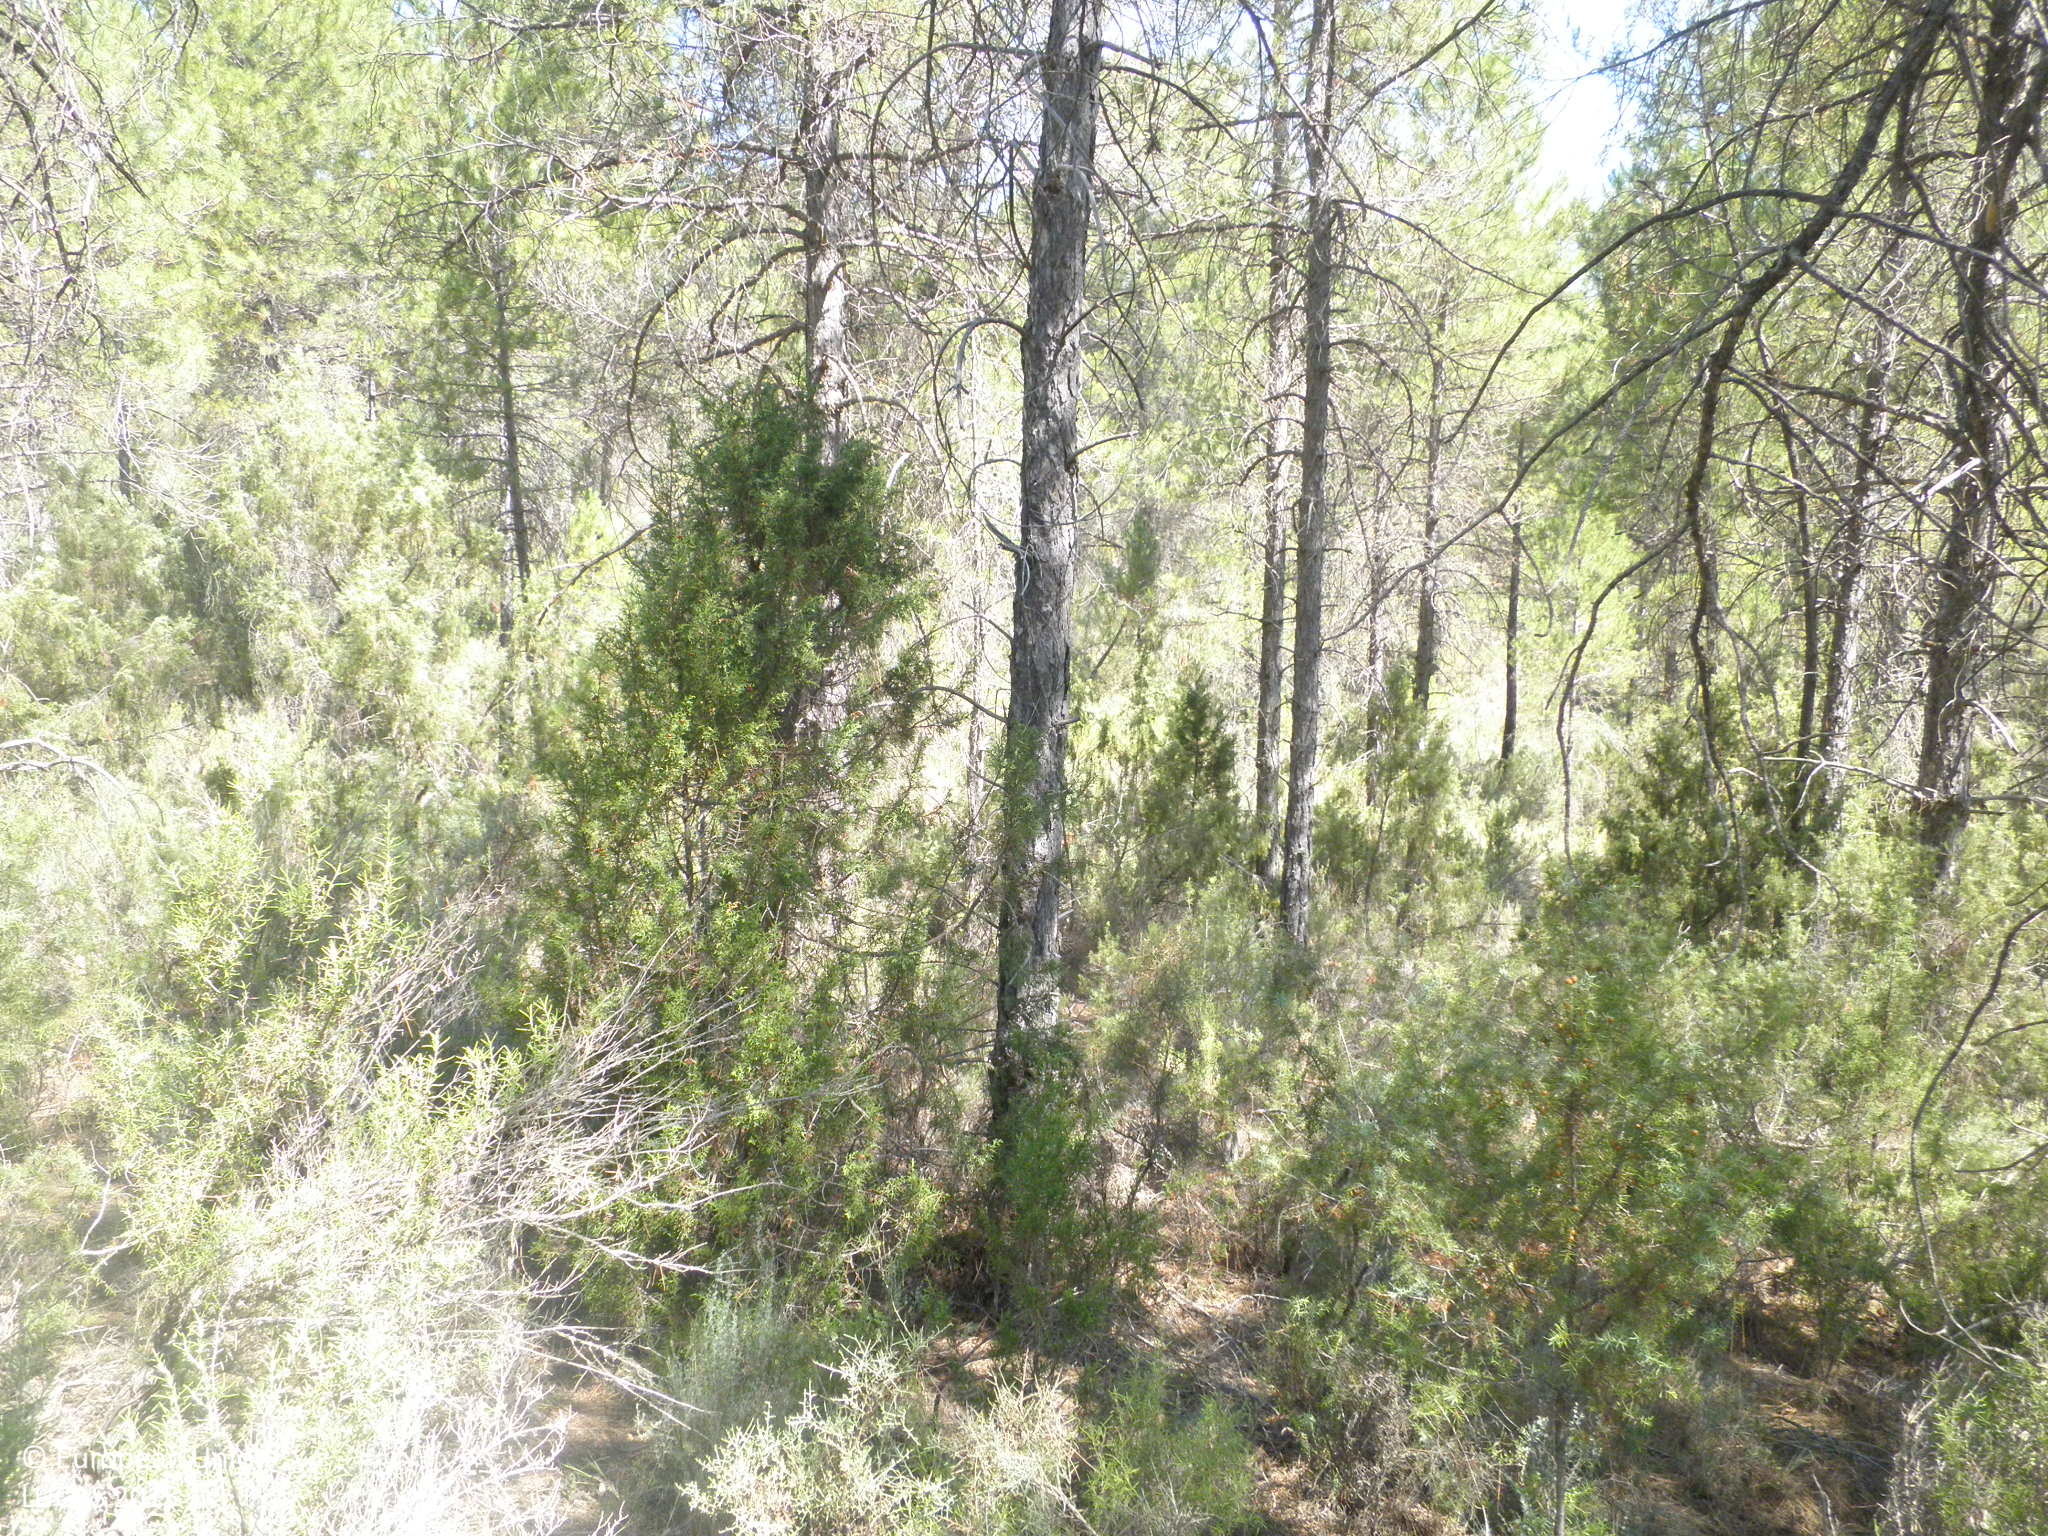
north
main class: Woodland
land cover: Pine dominated coniferous woodland
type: coniferous forest of the mediterranean region
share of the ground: 50 - 75 %
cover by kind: coniferous forest trees 60 %, unconsolidated bare surface 20 %, shrubs 15 %, herbaceous plants 5 %
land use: Semi-natural and natural areas not in use
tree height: > 5 m
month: July
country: ES
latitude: 39.6866
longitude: -1.7498
